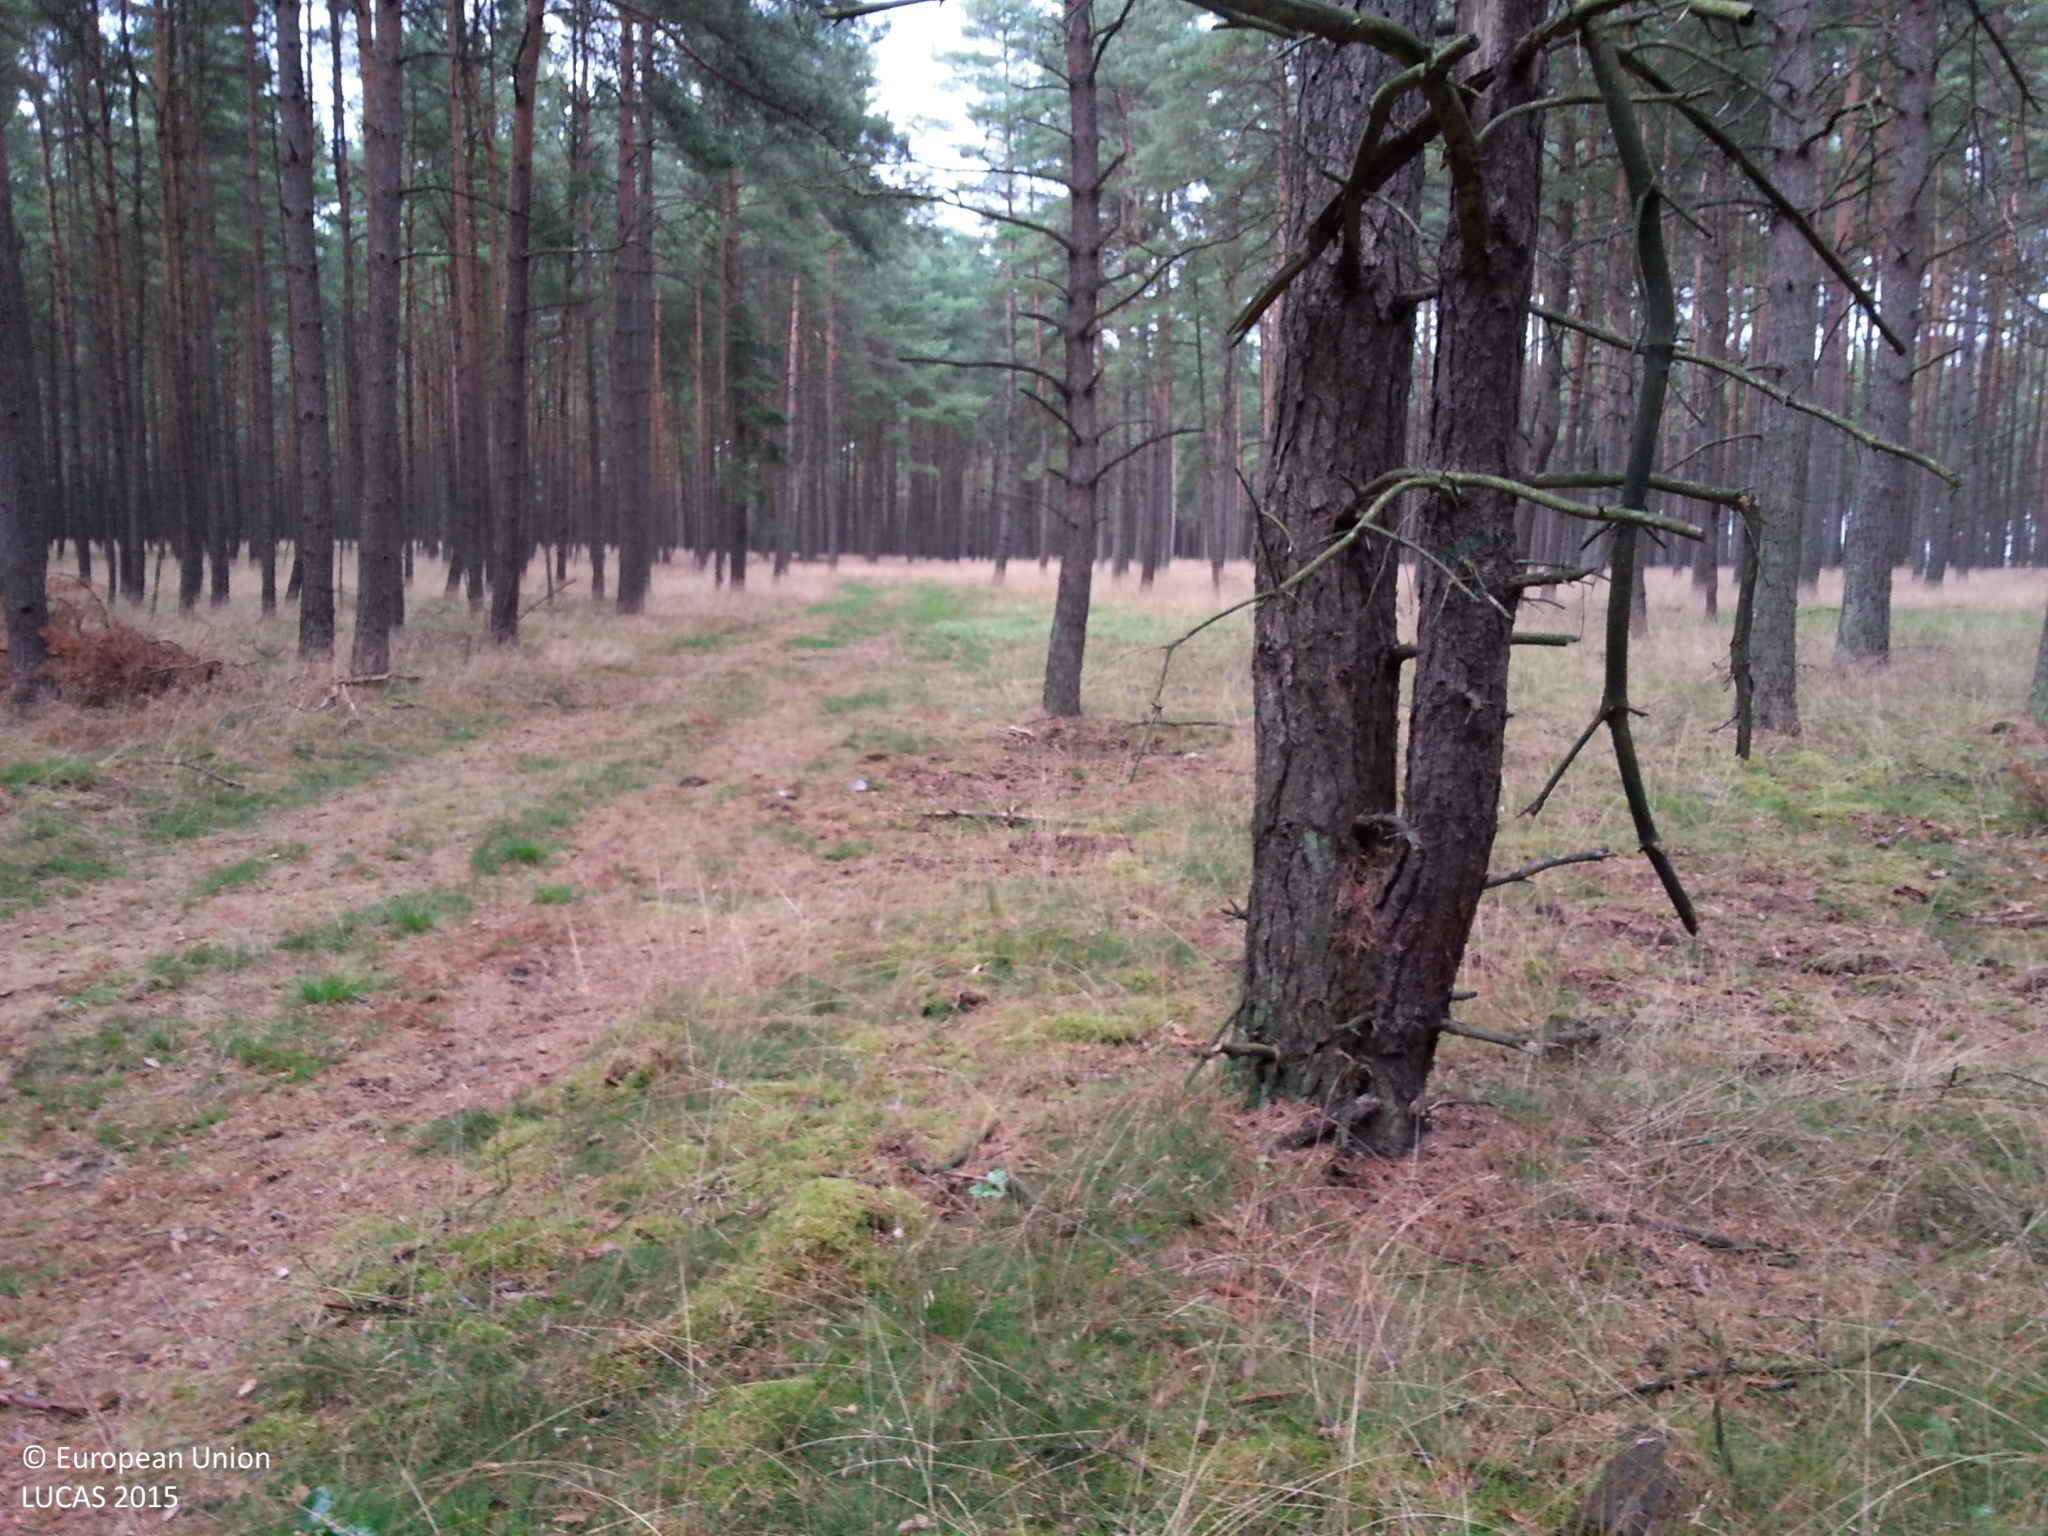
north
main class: Woodland
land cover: Pine dominated coniferous woodland
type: hemiboreal forest and nemoral coniferous forest and mixed broadleaved-coniferous forest
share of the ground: 50 - 75 %
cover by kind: coniferous forest trees 50 %, herbaceous plants 35 %, lichens and mosses 15 %
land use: Forestry
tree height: > 5 m
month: July
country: DE
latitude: 53.1095
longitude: 12.3447
